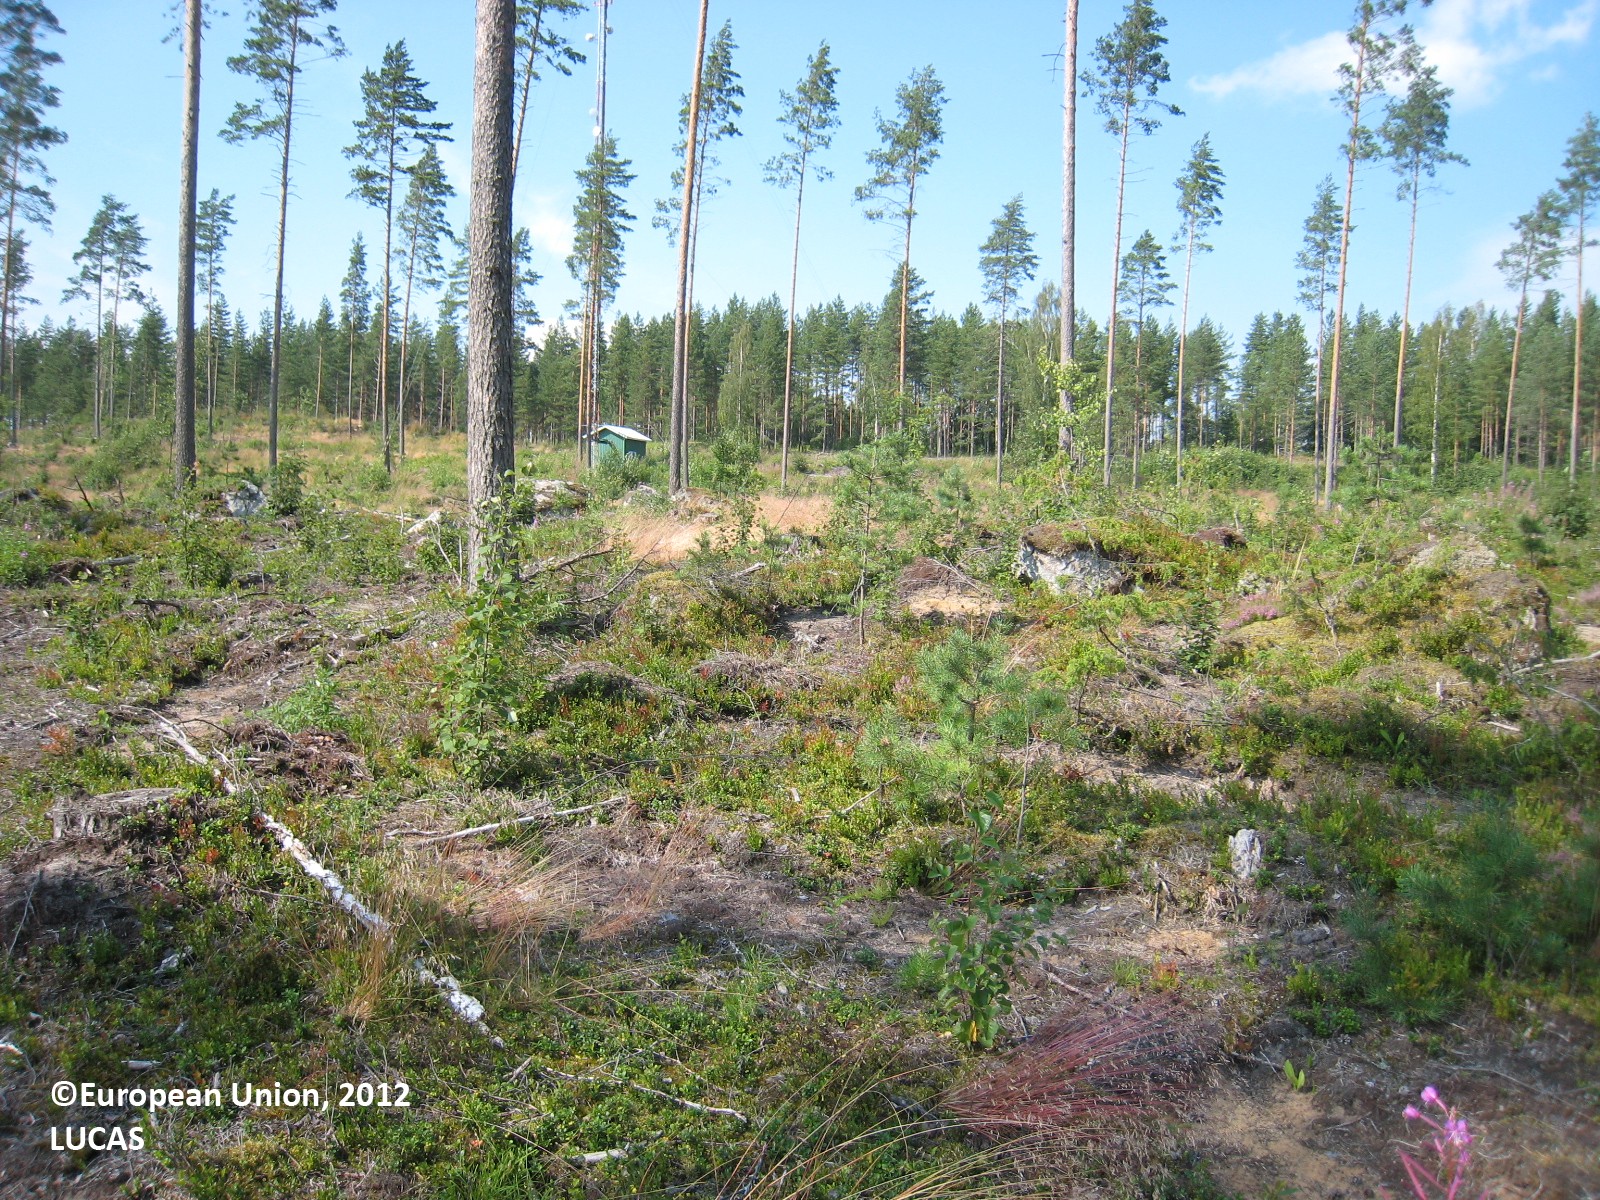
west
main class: Shrubland
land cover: Shrubland with sparse tree cover
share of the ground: > 75 %
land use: Forestry
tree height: > 5 m
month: July
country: FI
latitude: 61.7511
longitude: 26.1391
